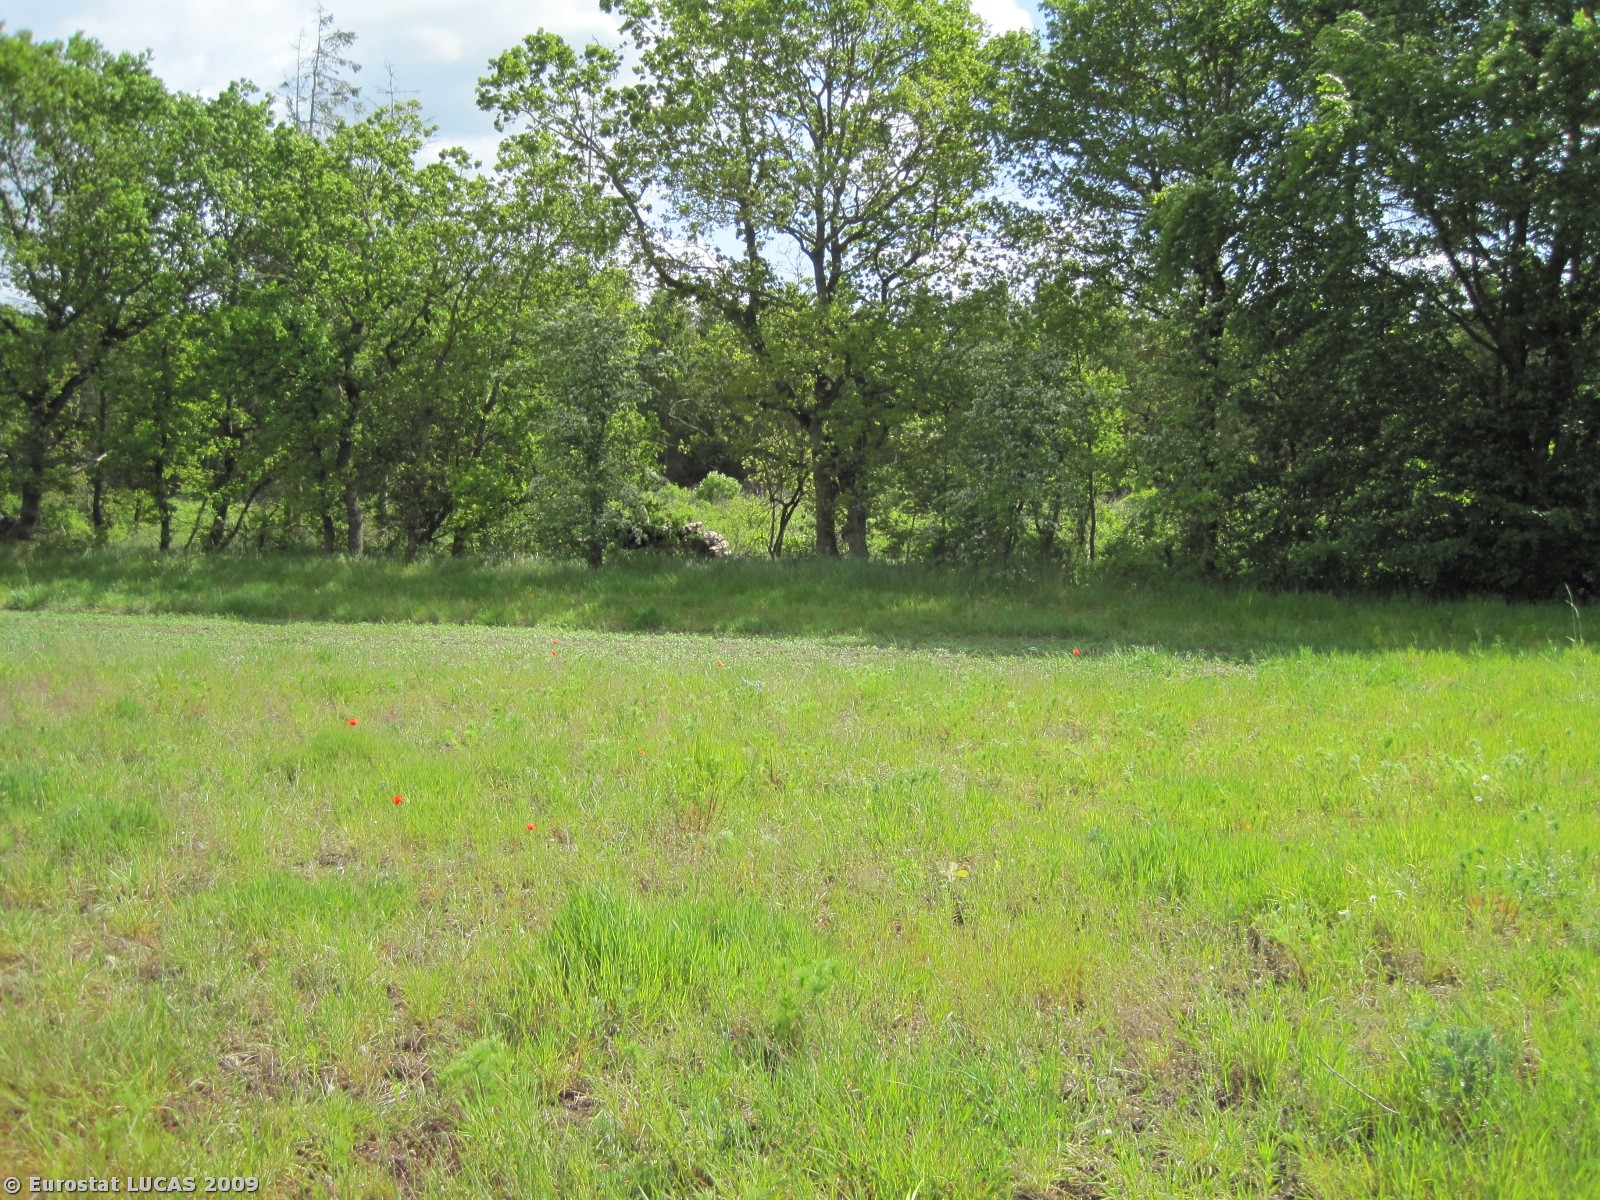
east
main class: Grassland
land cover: Grassland without tree/shrub cover
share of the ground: > 75 %
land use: Agriculture (excluding fallow land and kitchen gardens)
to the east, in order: Grassland without tree/shrub cover; Broadleaved woodland; Shrubland without tree cover; Grassland without tree/shrub cover; Shrubland without tree cover; Grassland without tree/shrub cover; Coniferous woodland; Grassland without tree/shrub cover; Fences; Coniferous woodland
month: May
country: DK
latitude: 56.5471
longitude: 9.7888
